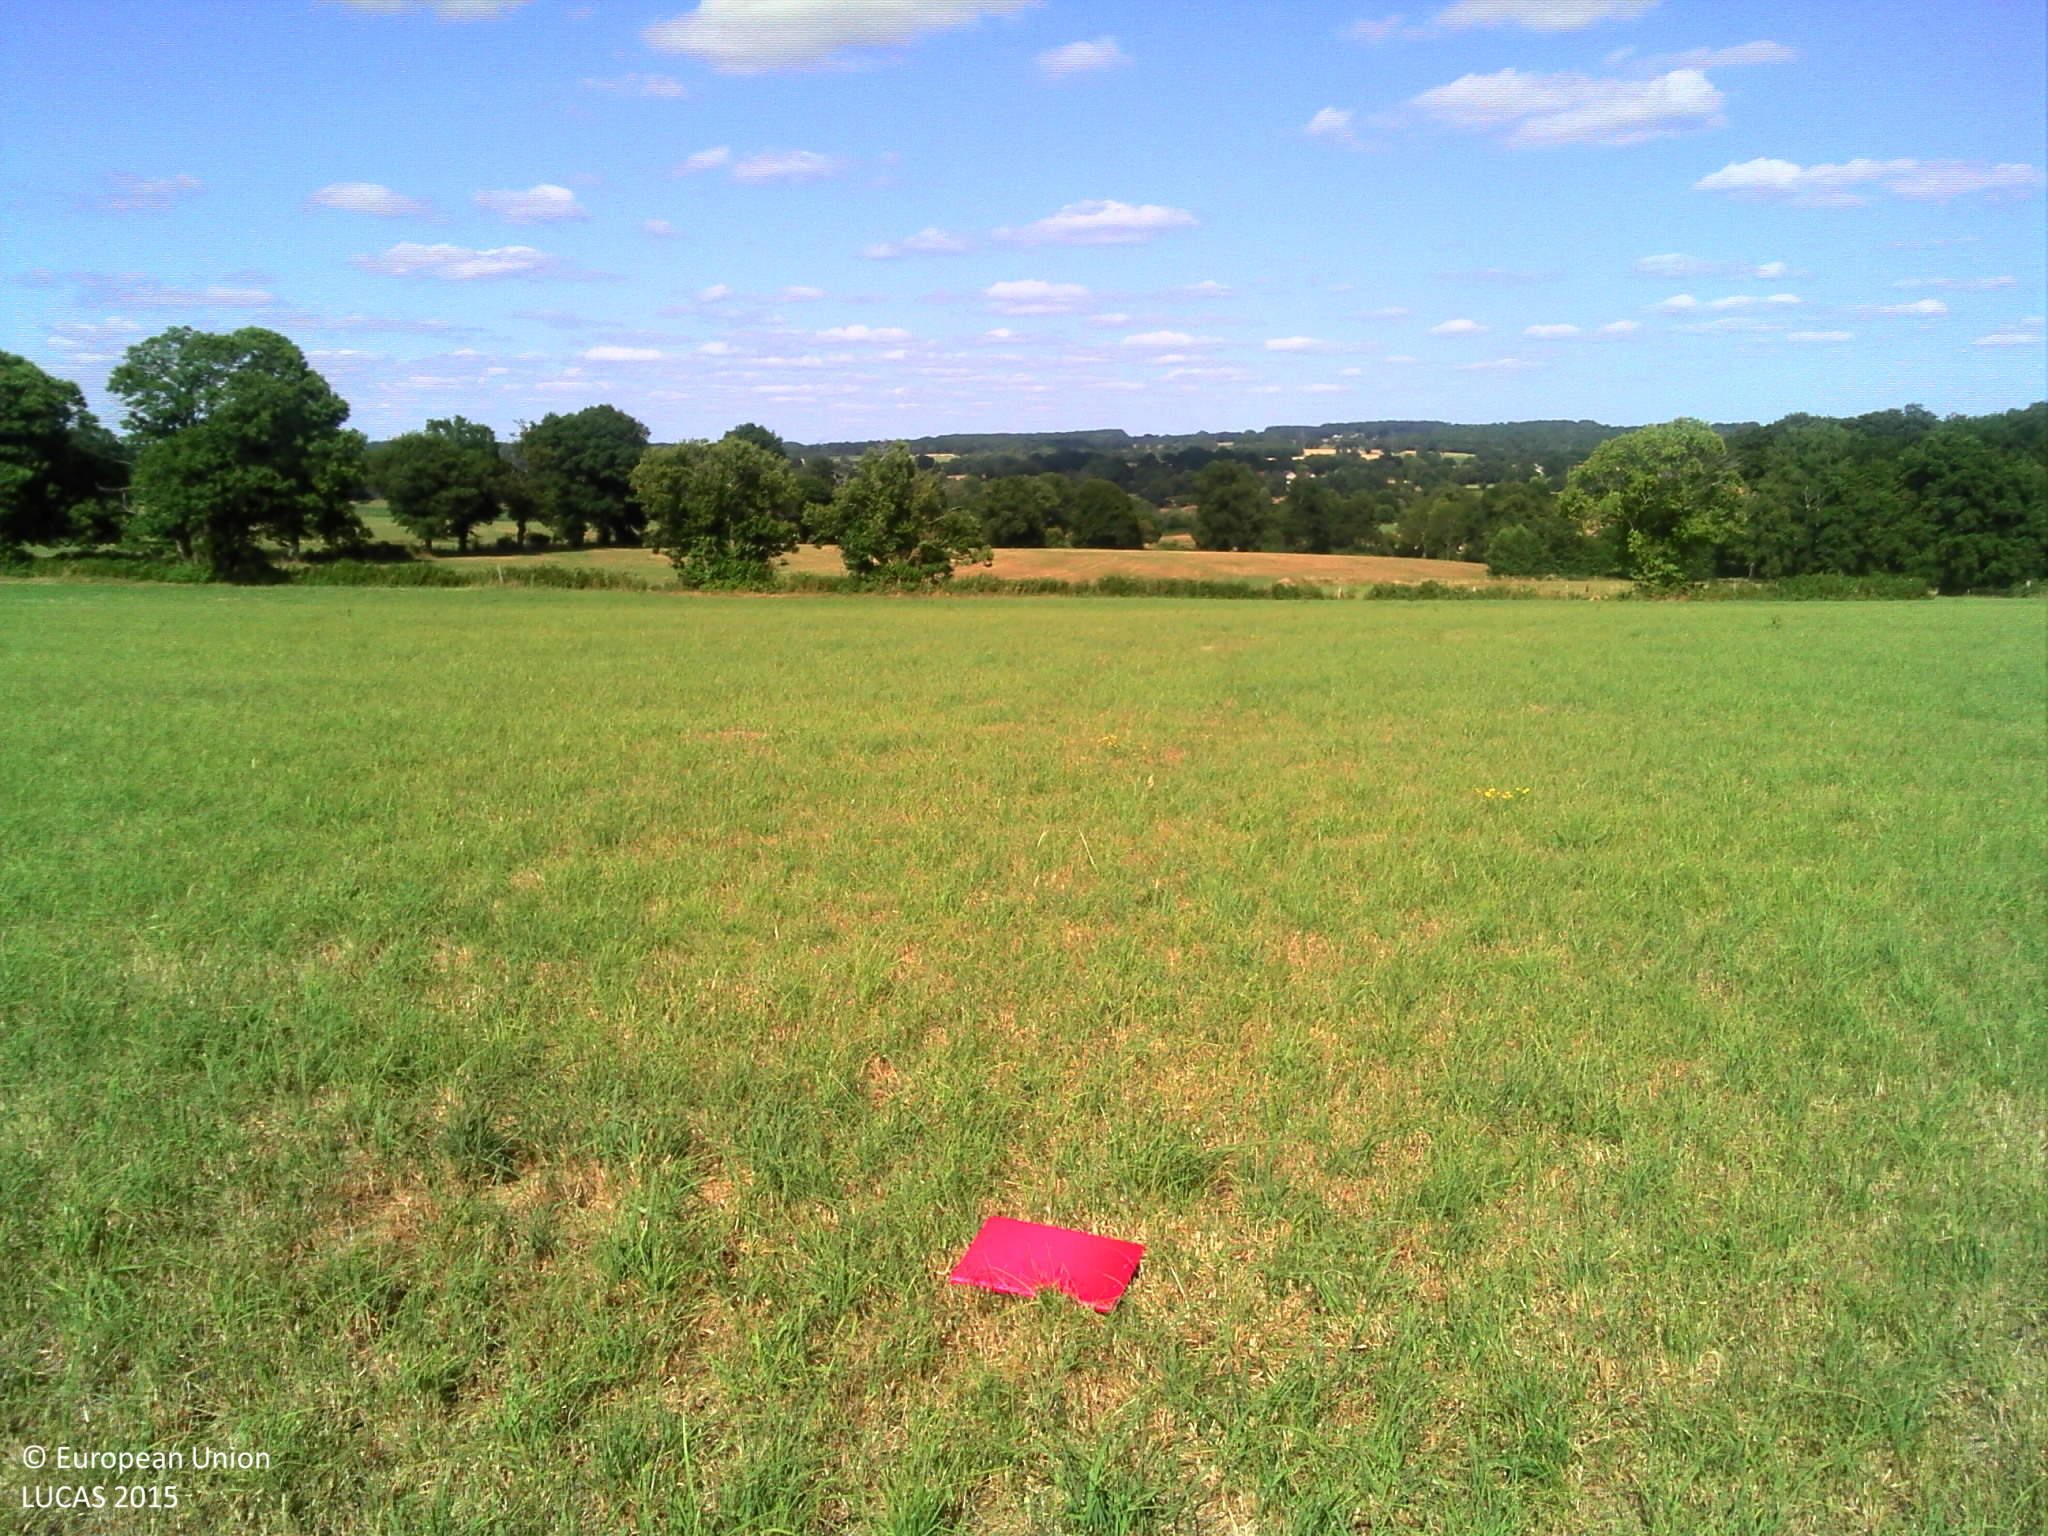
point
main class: Grassland
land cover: Grassland without tree/shrub cover
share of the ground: > 75 %
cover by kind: herbaceous plants 100 %
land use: Agriculture (excluding fallow land and kitchen gardens)
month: July
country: FR
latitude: 46.3113
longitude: 1.6155
